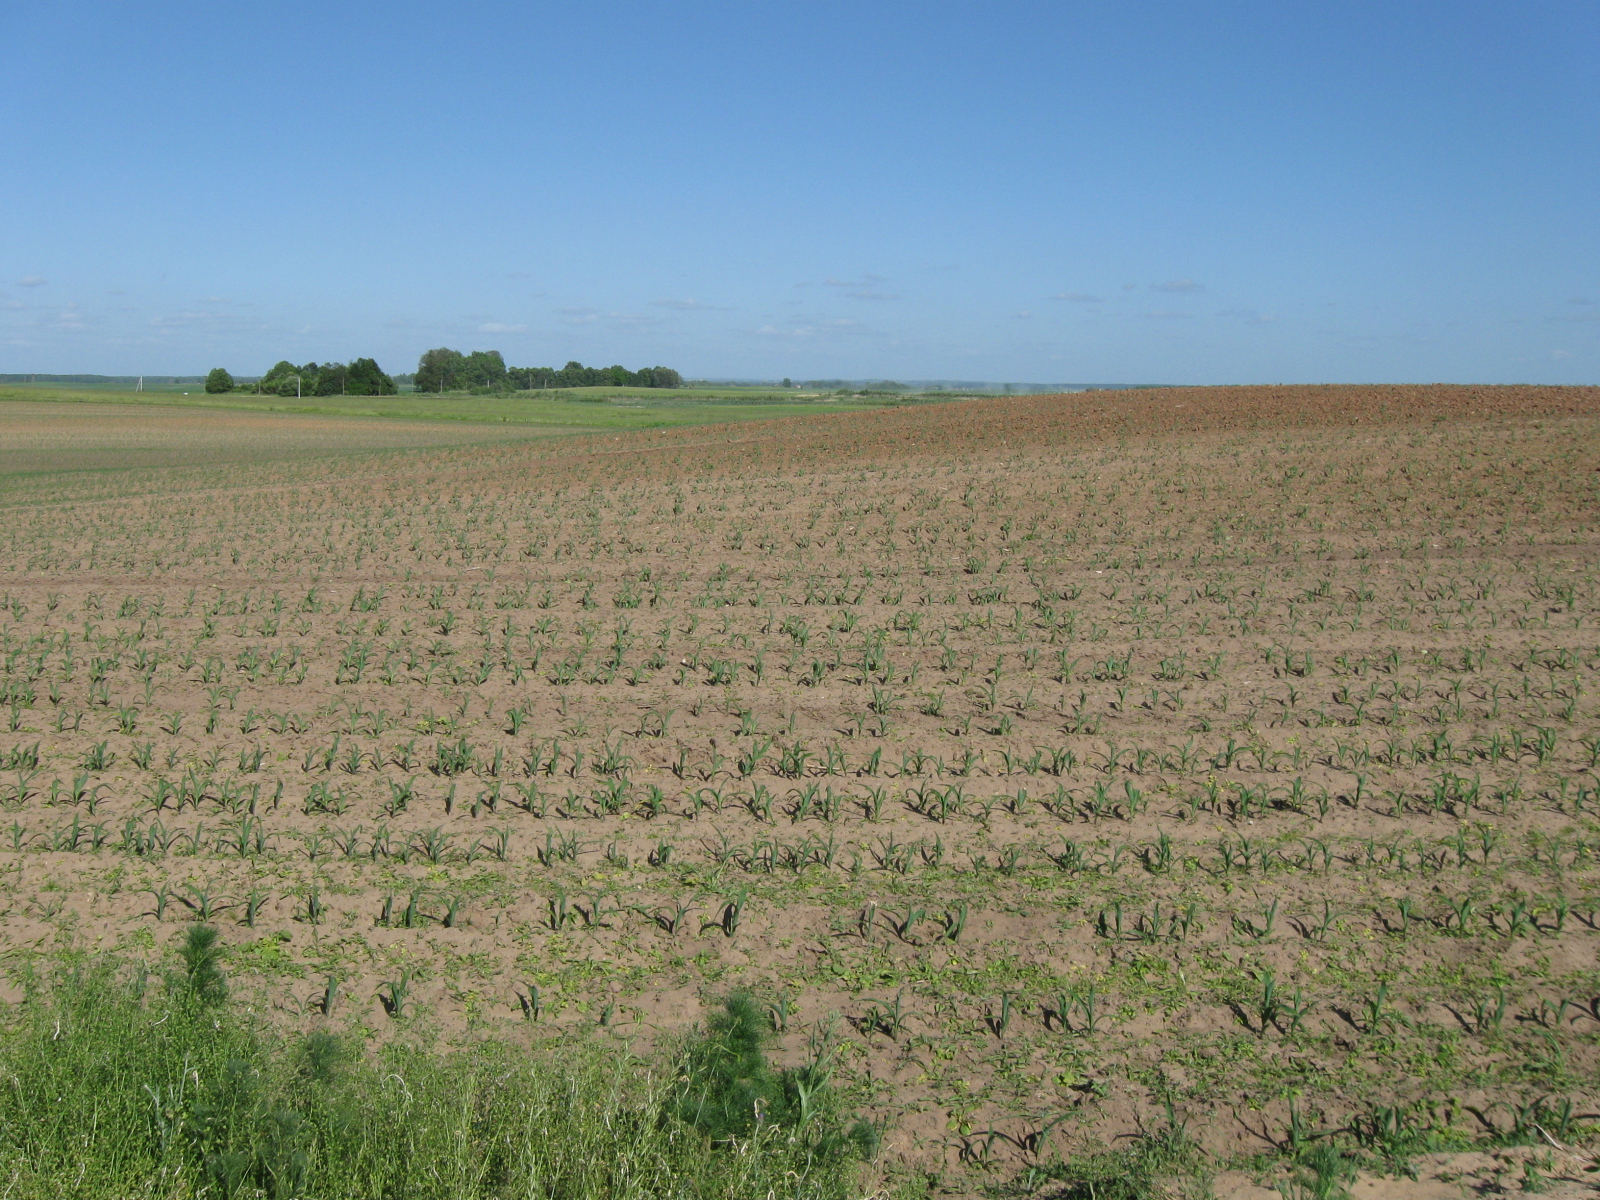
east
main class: Grassland
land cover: Spontaneously vegetated surfaces
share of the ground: > 75 %
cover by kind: herbaceous plants 100 %
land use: Fallow land
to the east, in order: Spontaneously vegetated surfaces; Maize; Grassland without tree/shrub cover
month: June
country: LT
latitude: 54.4469
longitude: 23.6717
